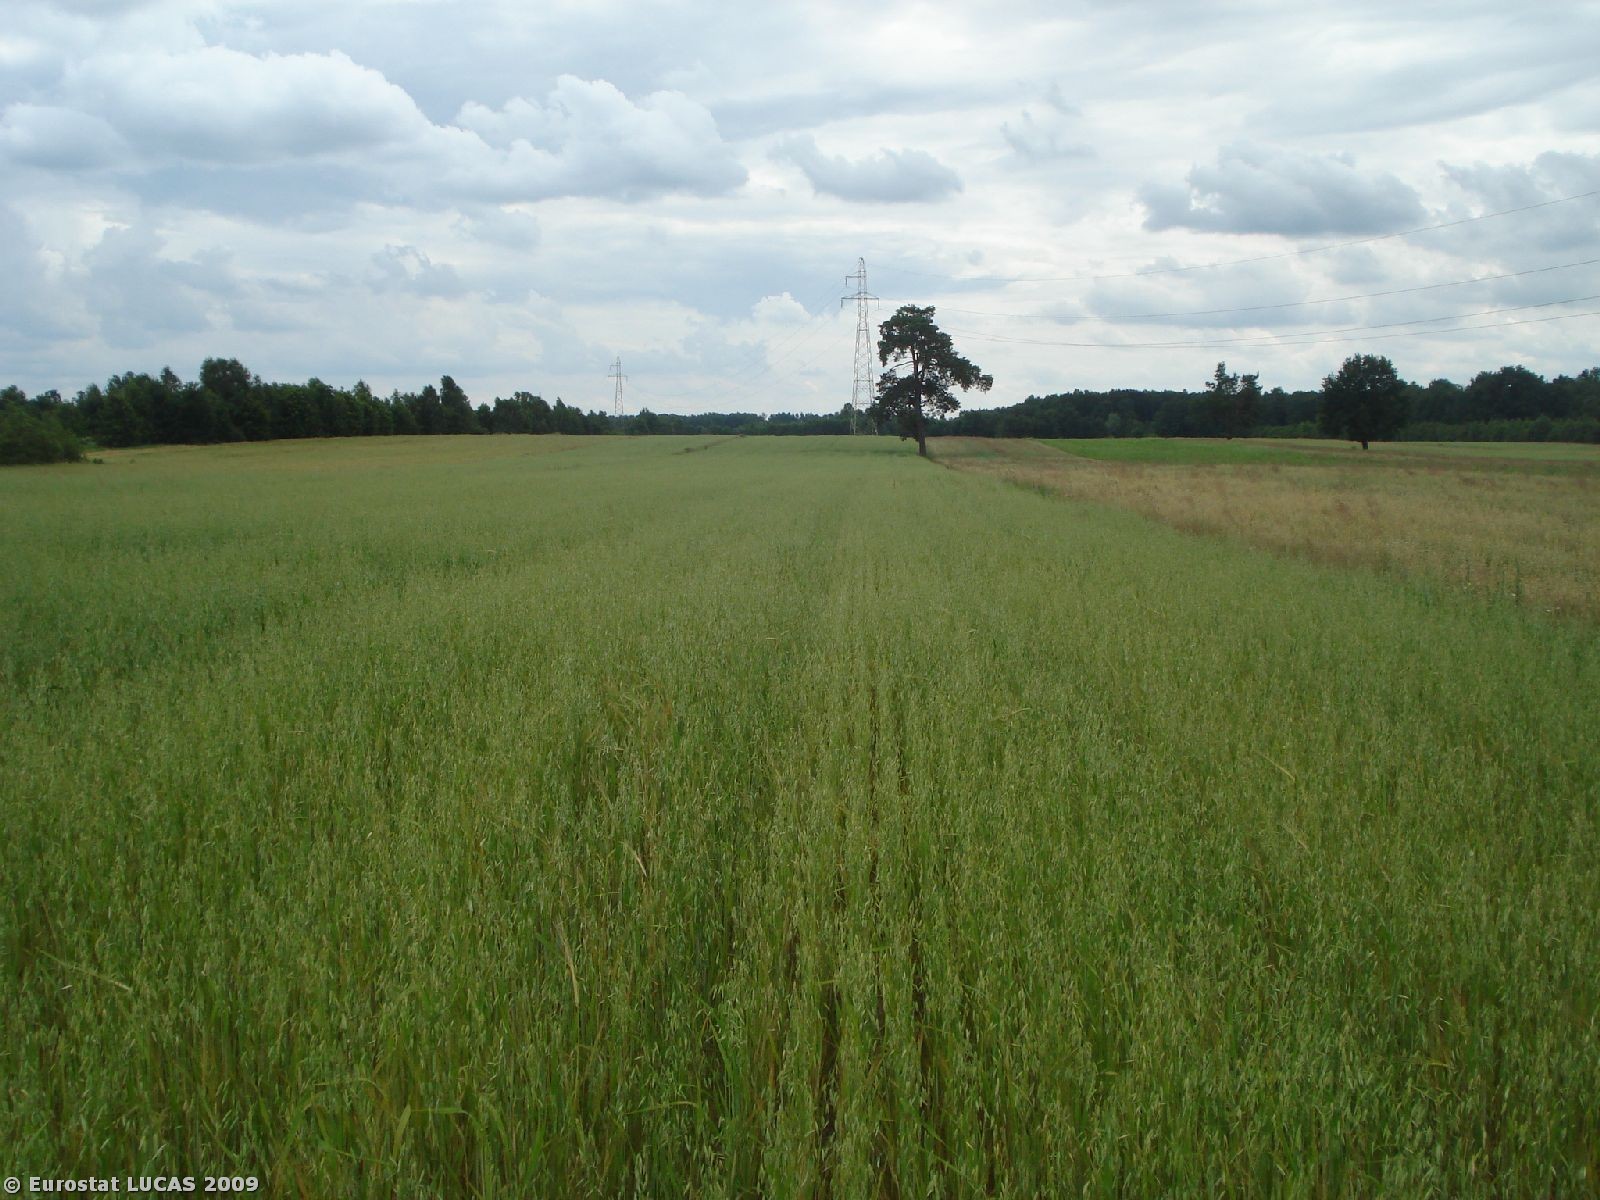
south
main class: Cropland
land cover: Oats
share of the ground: > 75 %
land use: Agriculture (excluding fallow land and kitchen gardens)
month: July
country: PL
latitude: 51.2883
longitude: 23.0528
